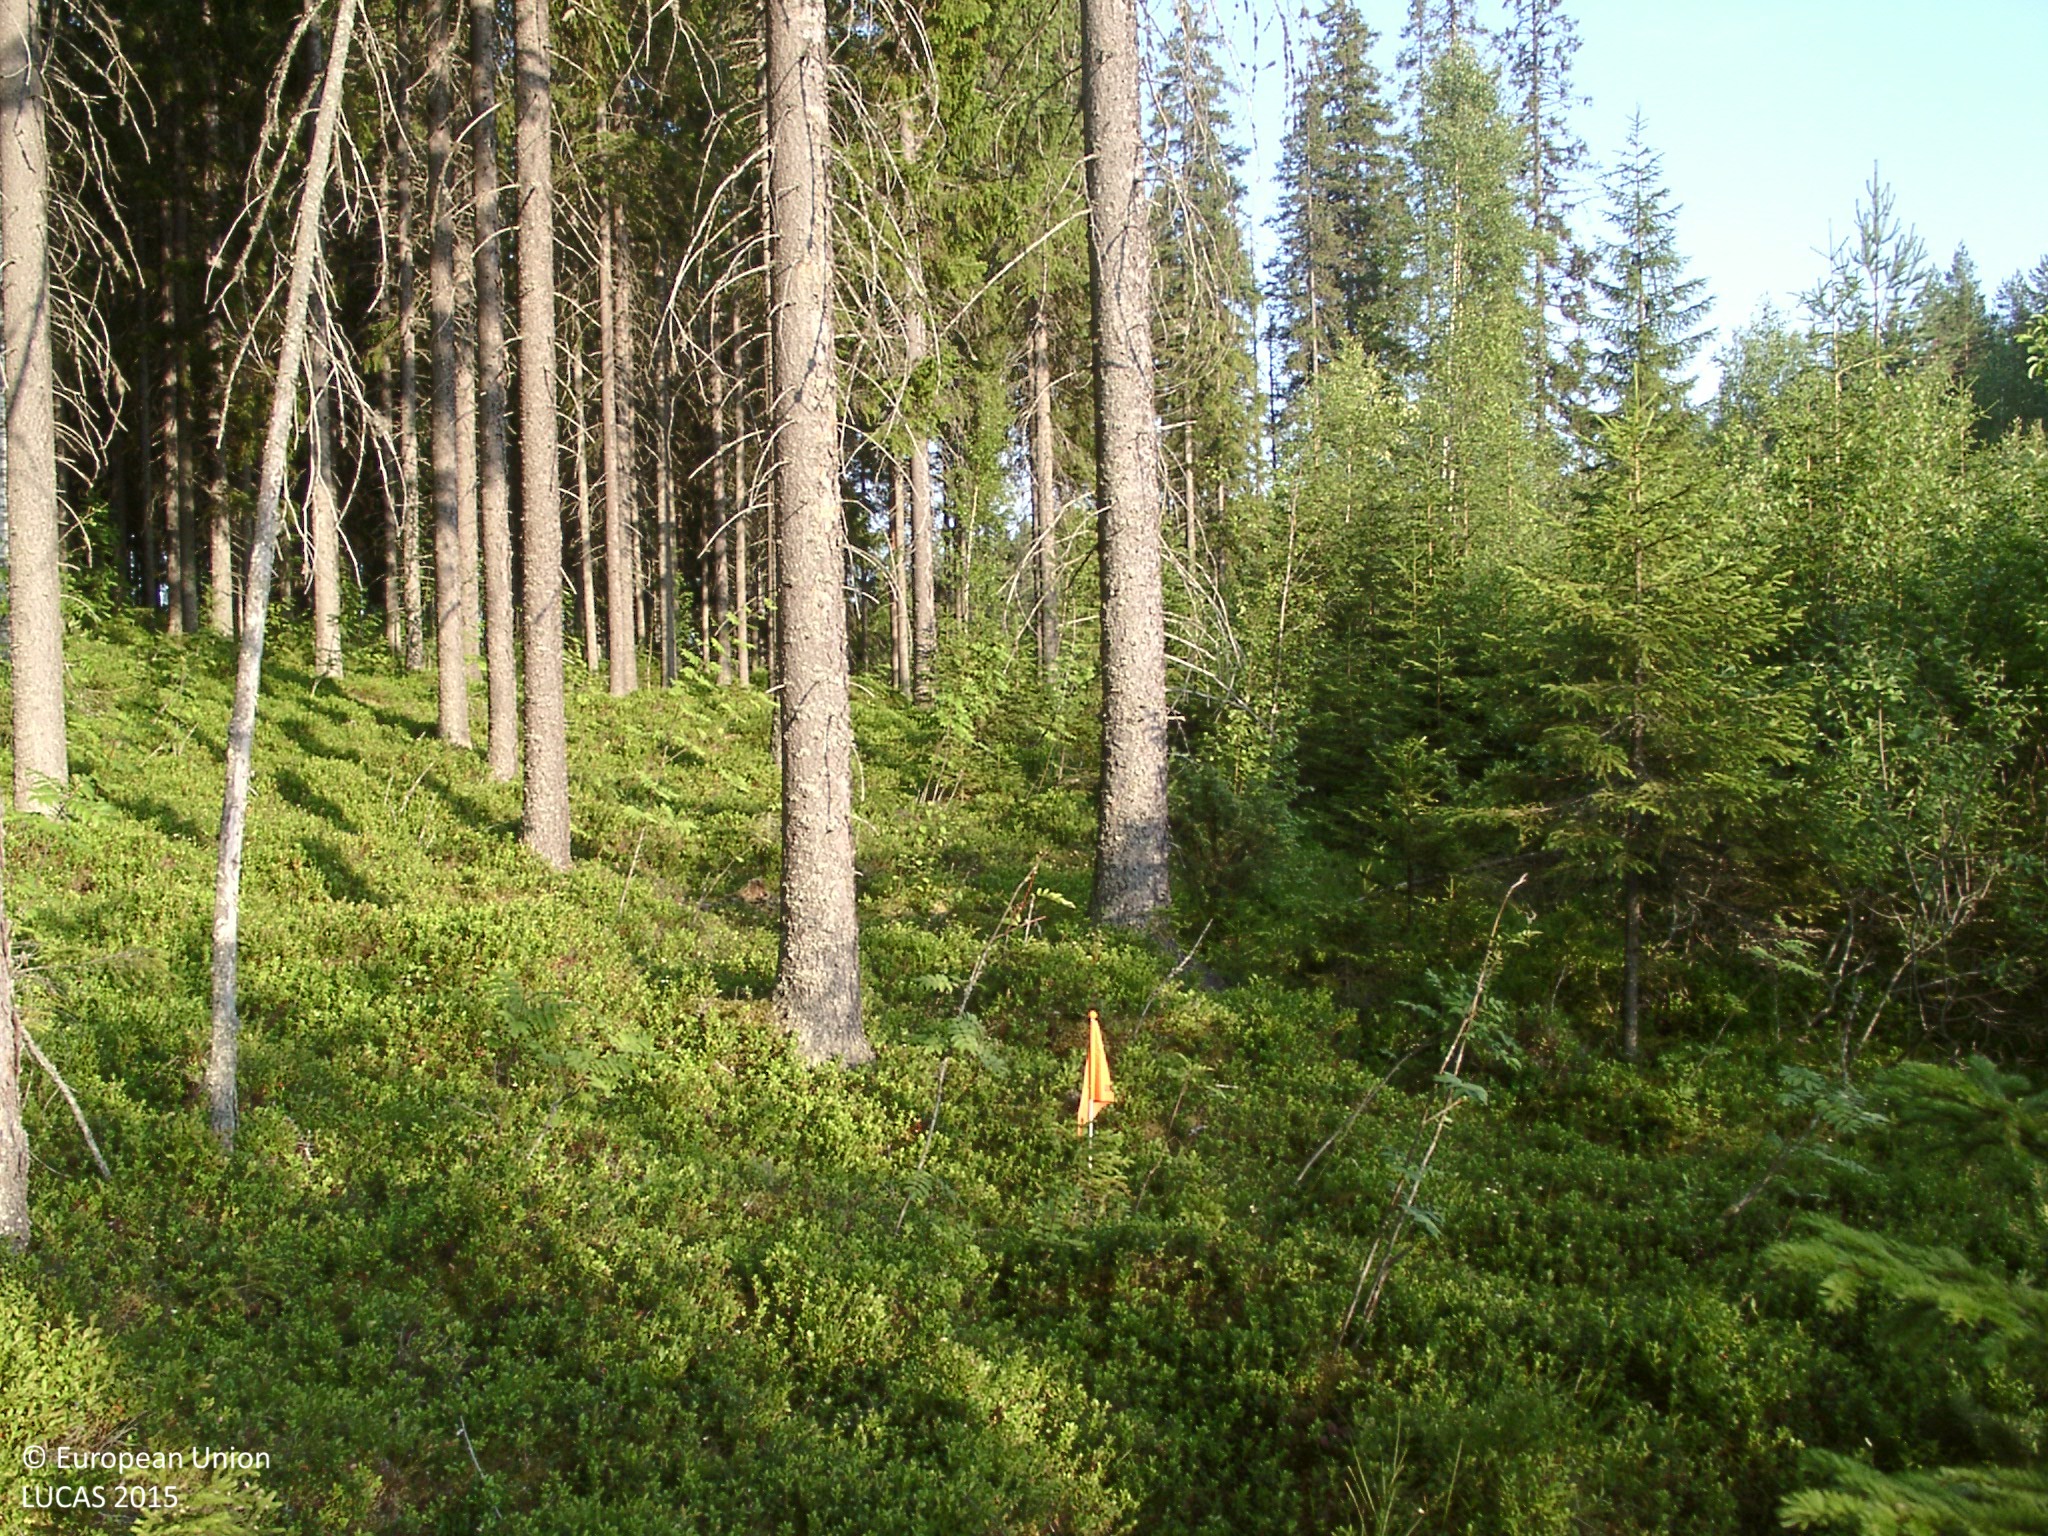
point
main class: Woodland
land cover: Spruce dominated coniferous woodland
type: boreal forest
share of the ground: > 75 %
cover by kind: coniferous forest trees 70 %, shrubs 20 %, broadleaved forest trees 5 %, lichens and mosses 5 %
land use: Forestry
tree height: > 5 m
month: July
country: FI
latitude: 61.8048
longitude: 24.7674
